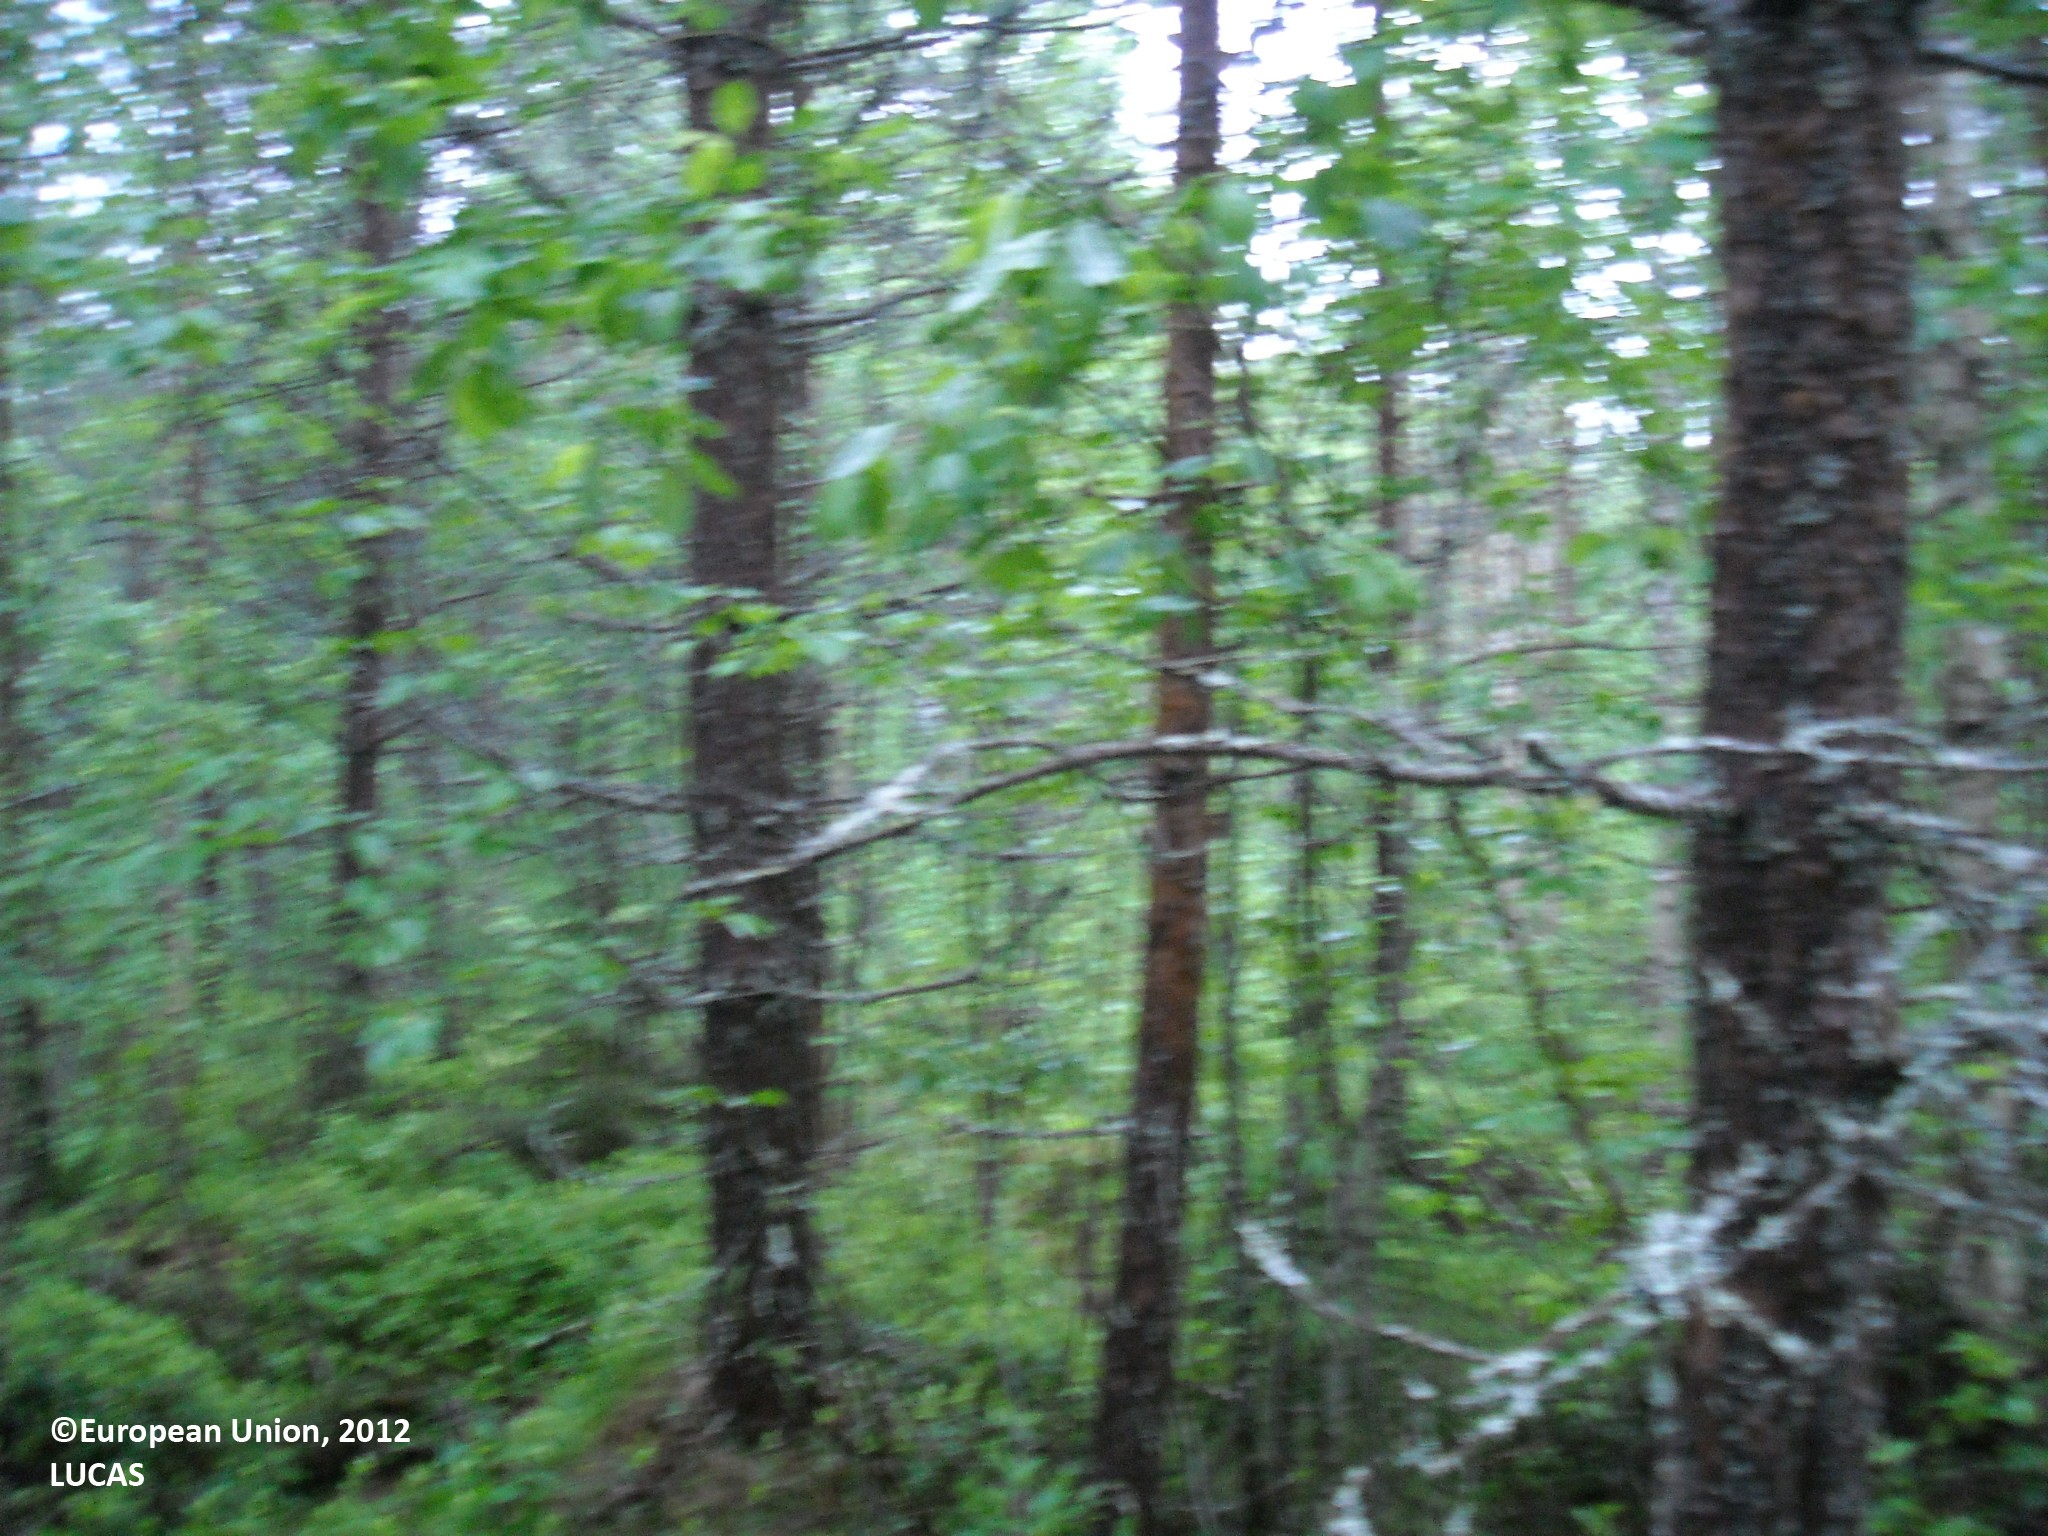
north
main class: Woodland
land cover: Pine dominated mixed woodland
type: boreal forest
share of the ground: > 75 %
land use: Forestry
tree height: > 5 m
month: July
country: FI
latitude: 65.0403
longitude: 28.1015
